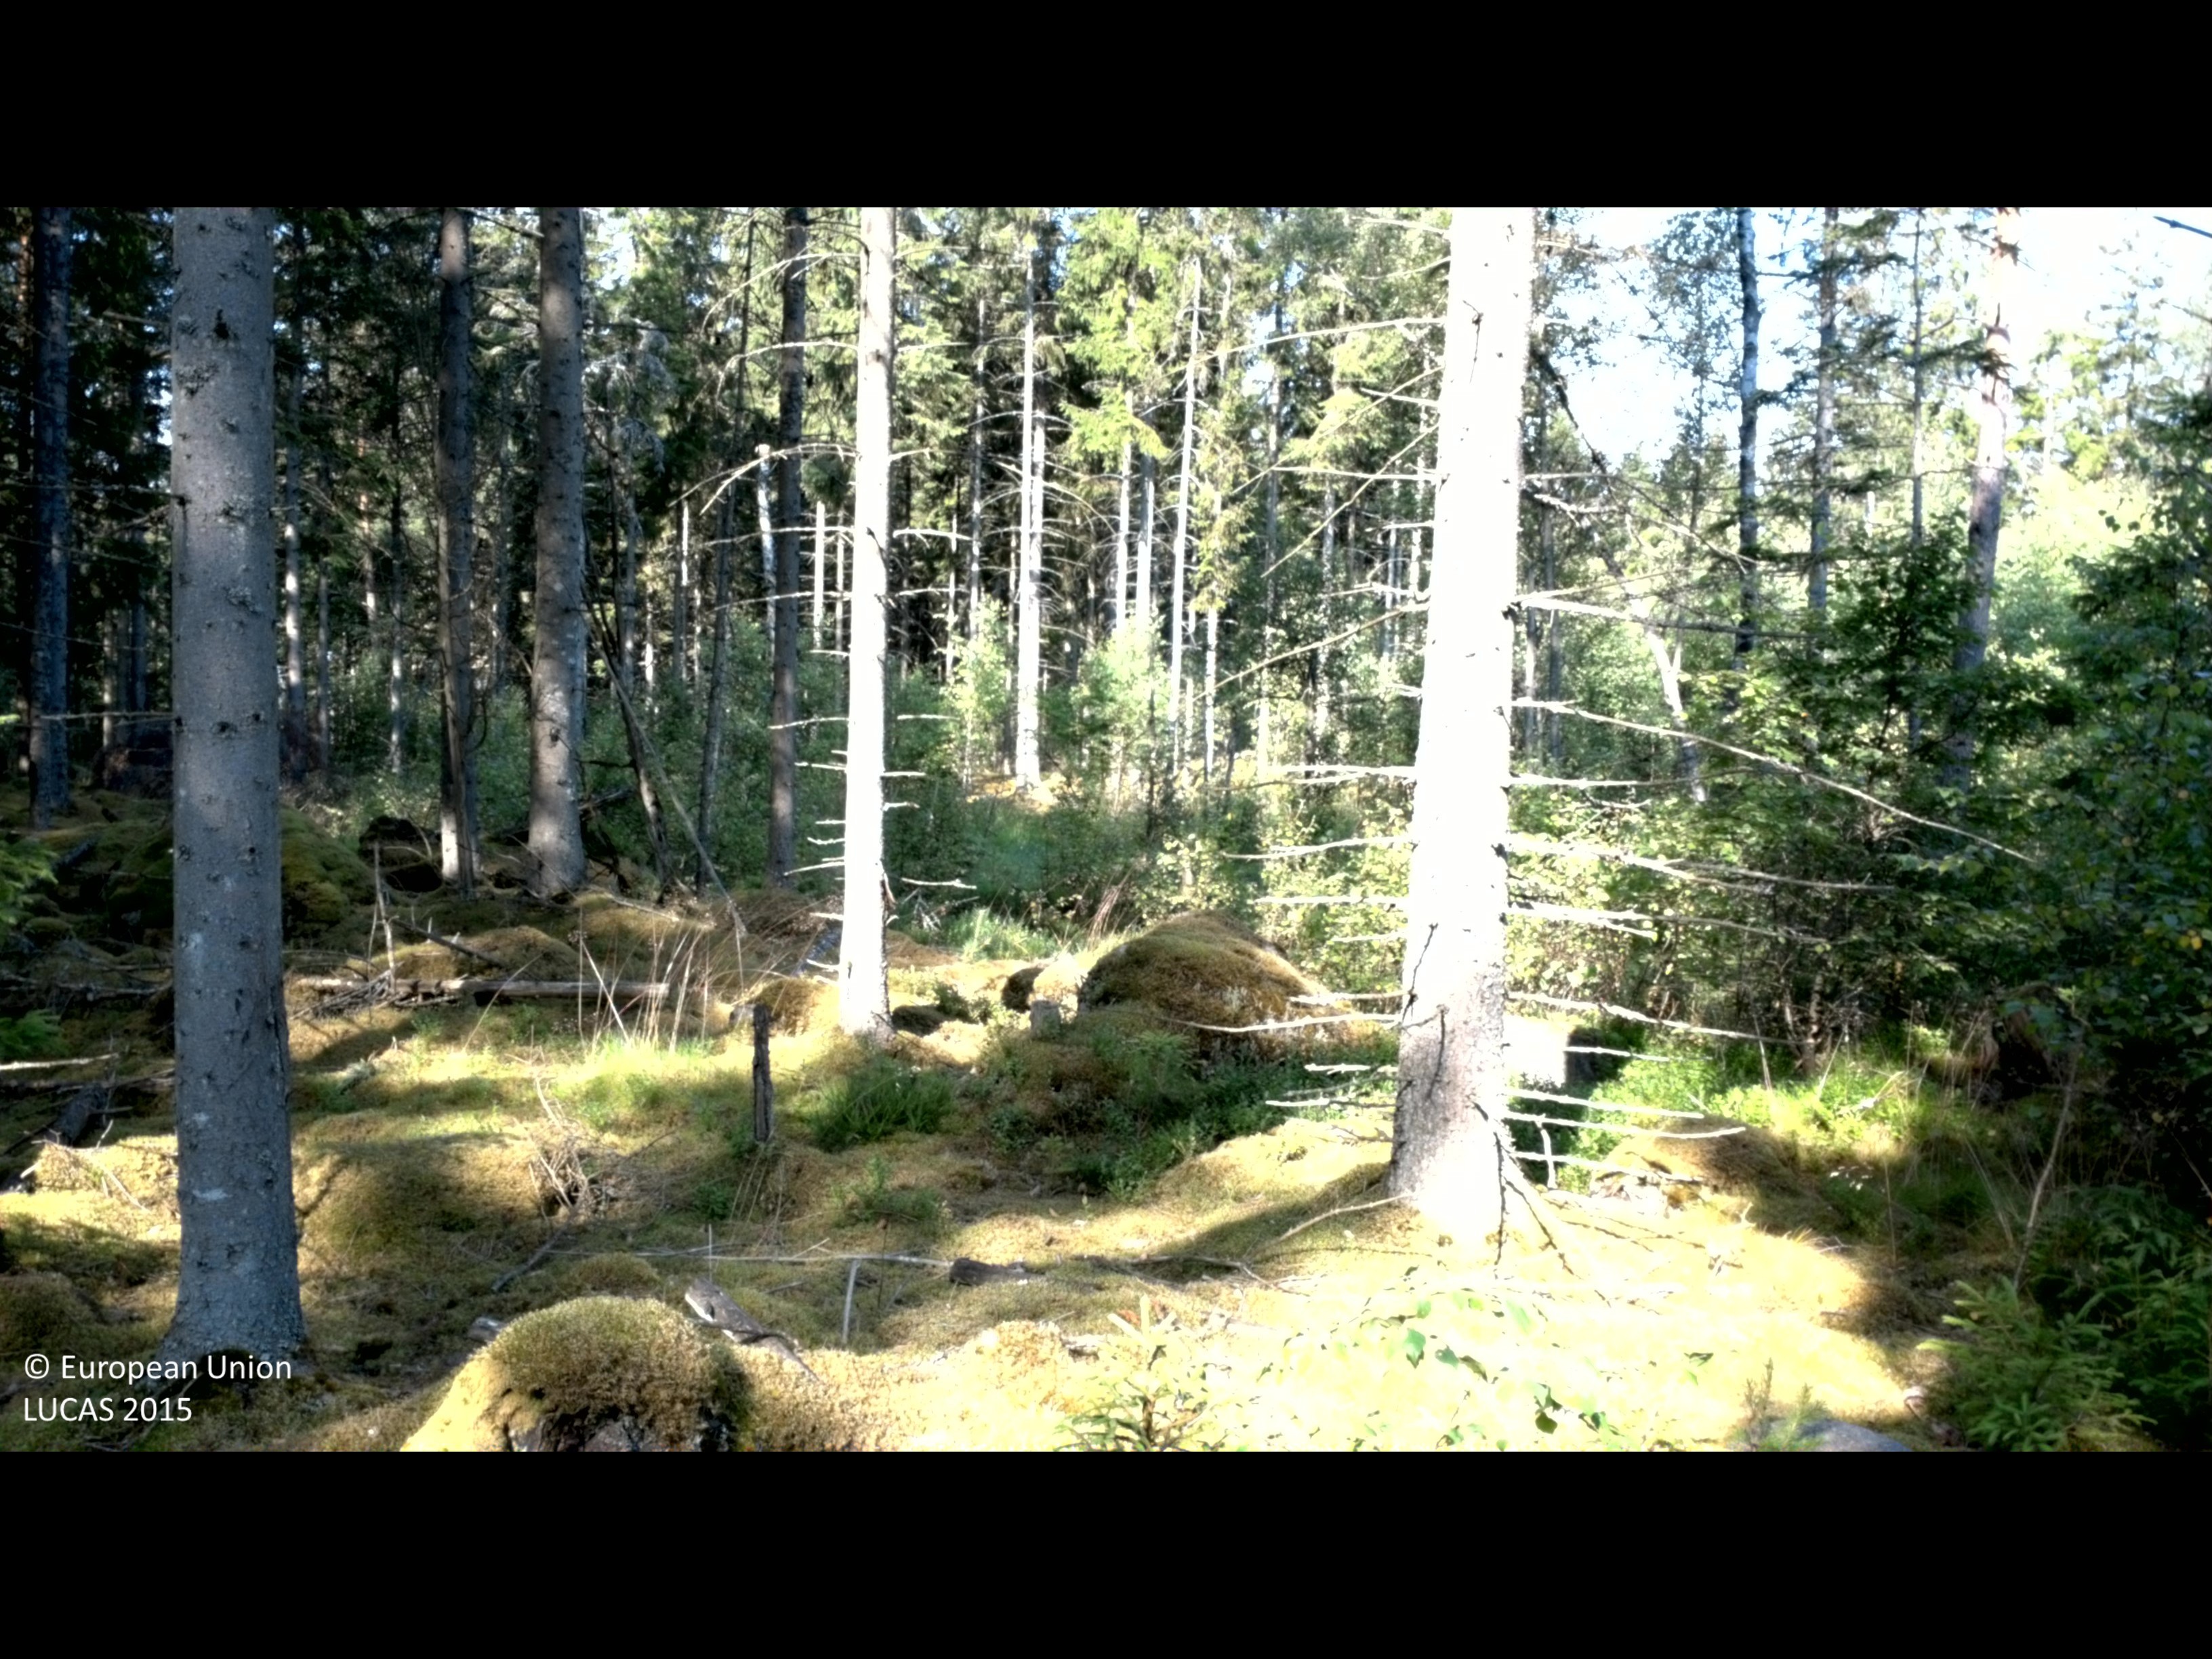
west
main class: Woodland
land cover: Spruce dominated coniferous woodland
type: boreal forest
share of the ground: 50 - 75 %
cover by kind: coniferous forest trees 70 %, lichens and mosses 20 %, shrubs 10 %
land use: Forestry
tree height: > 5 m
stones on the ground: 25 - 50 %
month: August
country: SE
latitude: 56.6457
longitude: 14.0576
